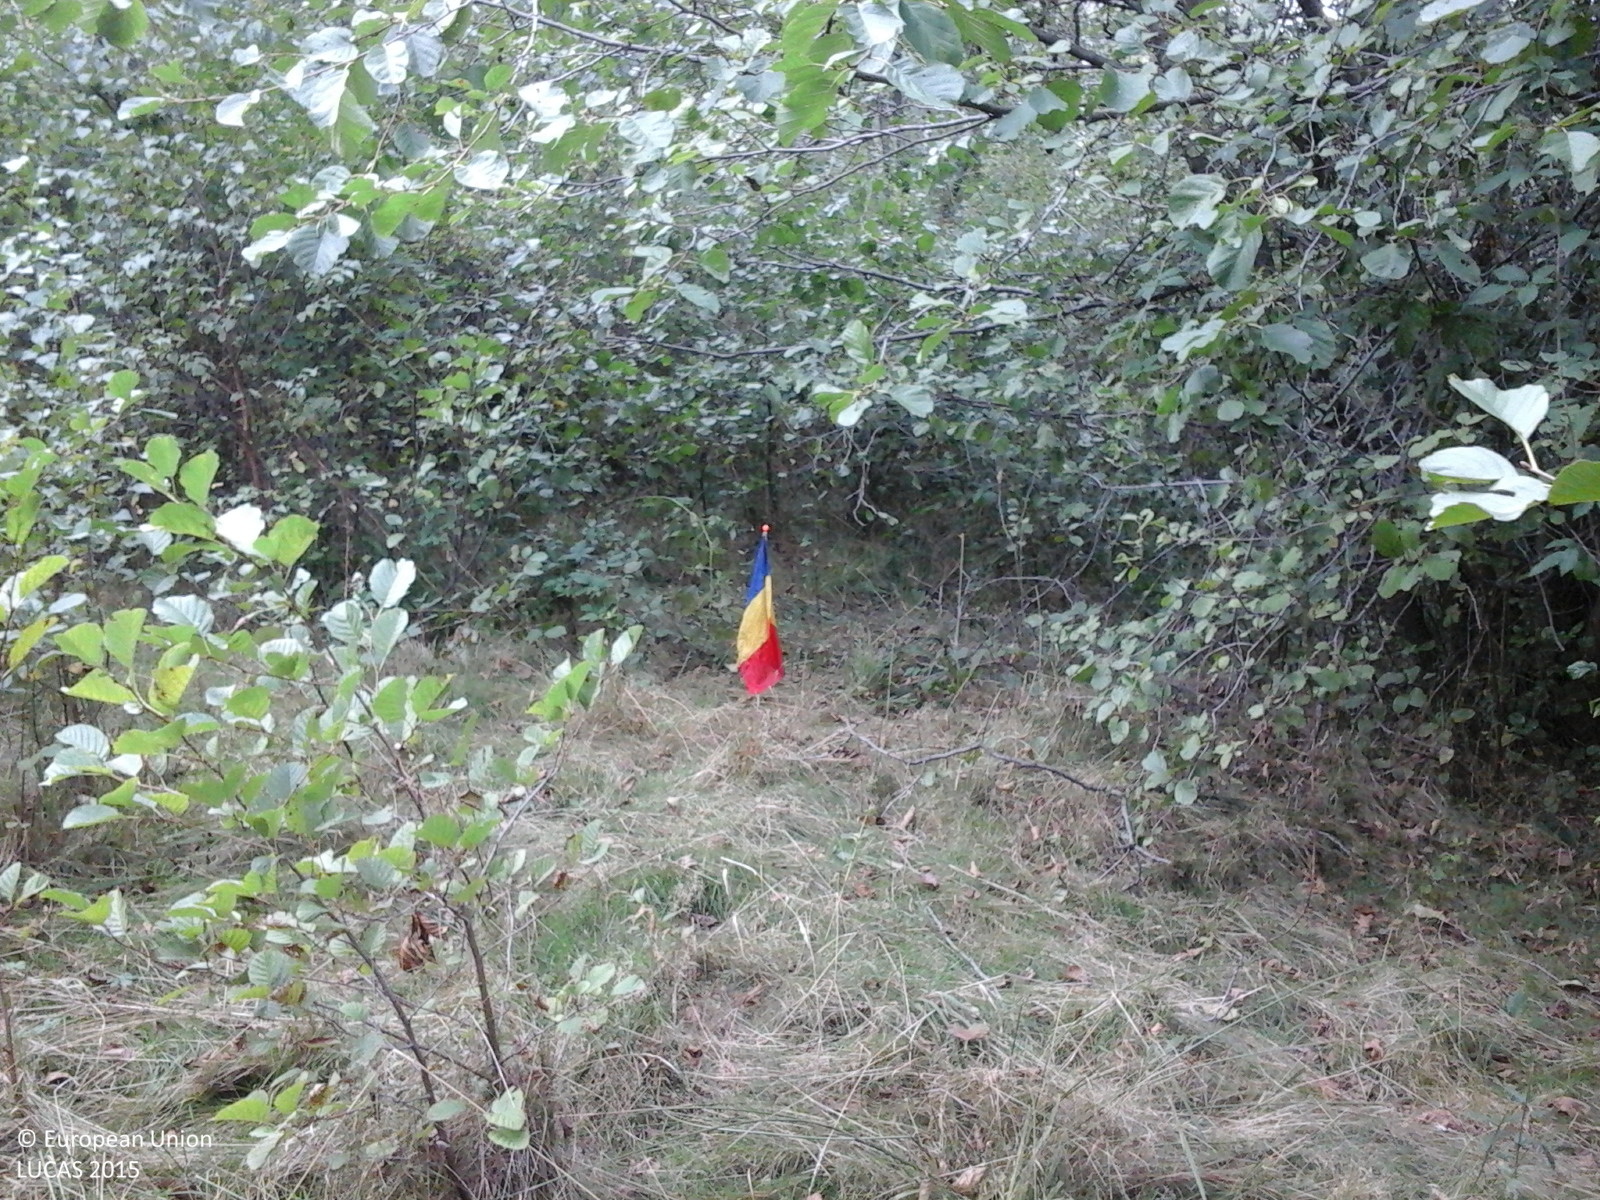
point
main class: Woodland
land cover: Broadleaved woodland
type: non-riverine alder, birch or aspen forest
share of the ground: > 75 %
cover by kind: broadleaved forest trees 100 %
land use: Forestry
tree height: > 5 m
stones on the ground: < 10 %
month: September
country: RO
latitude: 45.4573
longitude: 23.1888
